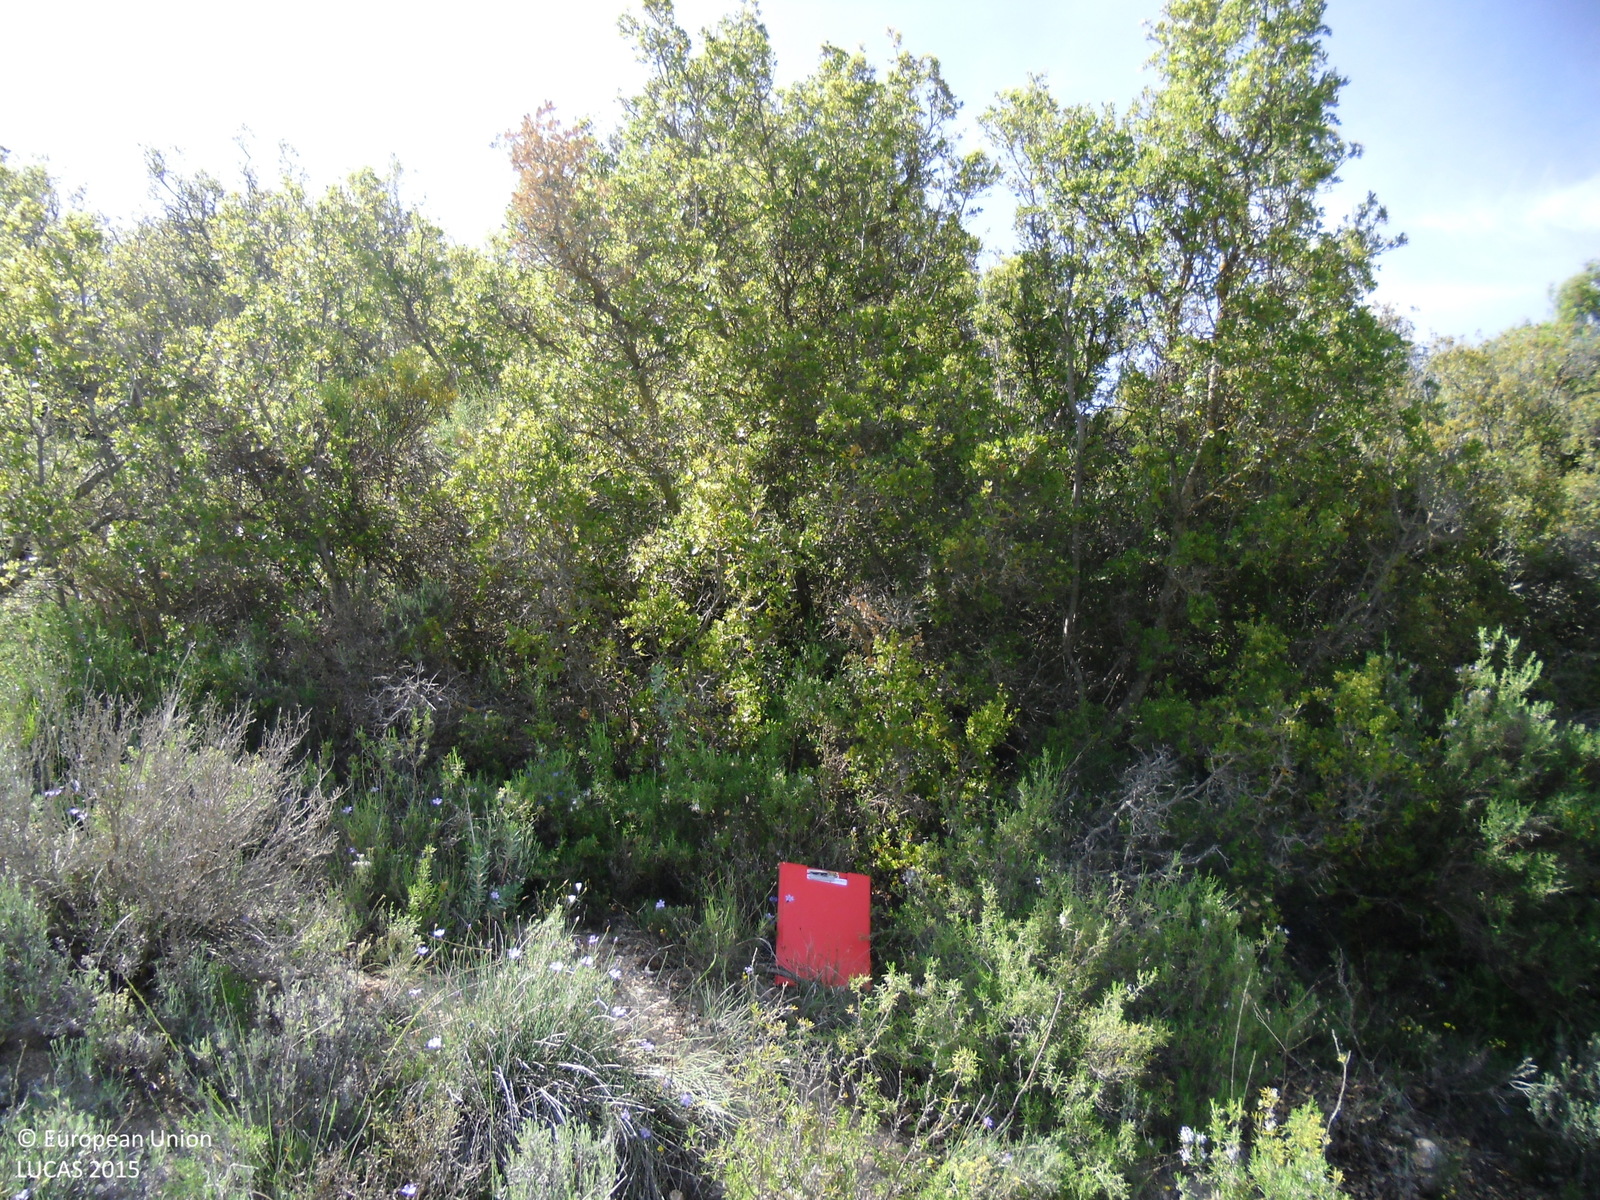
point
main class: Shrubland
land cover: Shrubland with sparse tree cover
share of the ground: 50 - 75 %
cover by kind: shrubs 65 %, herbaceous plants 30 %, broadleaved forest trees 5 %
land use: Semi-natural and natural areas not in use
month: May
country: ES
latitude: 40.4671
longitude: -2.9432
